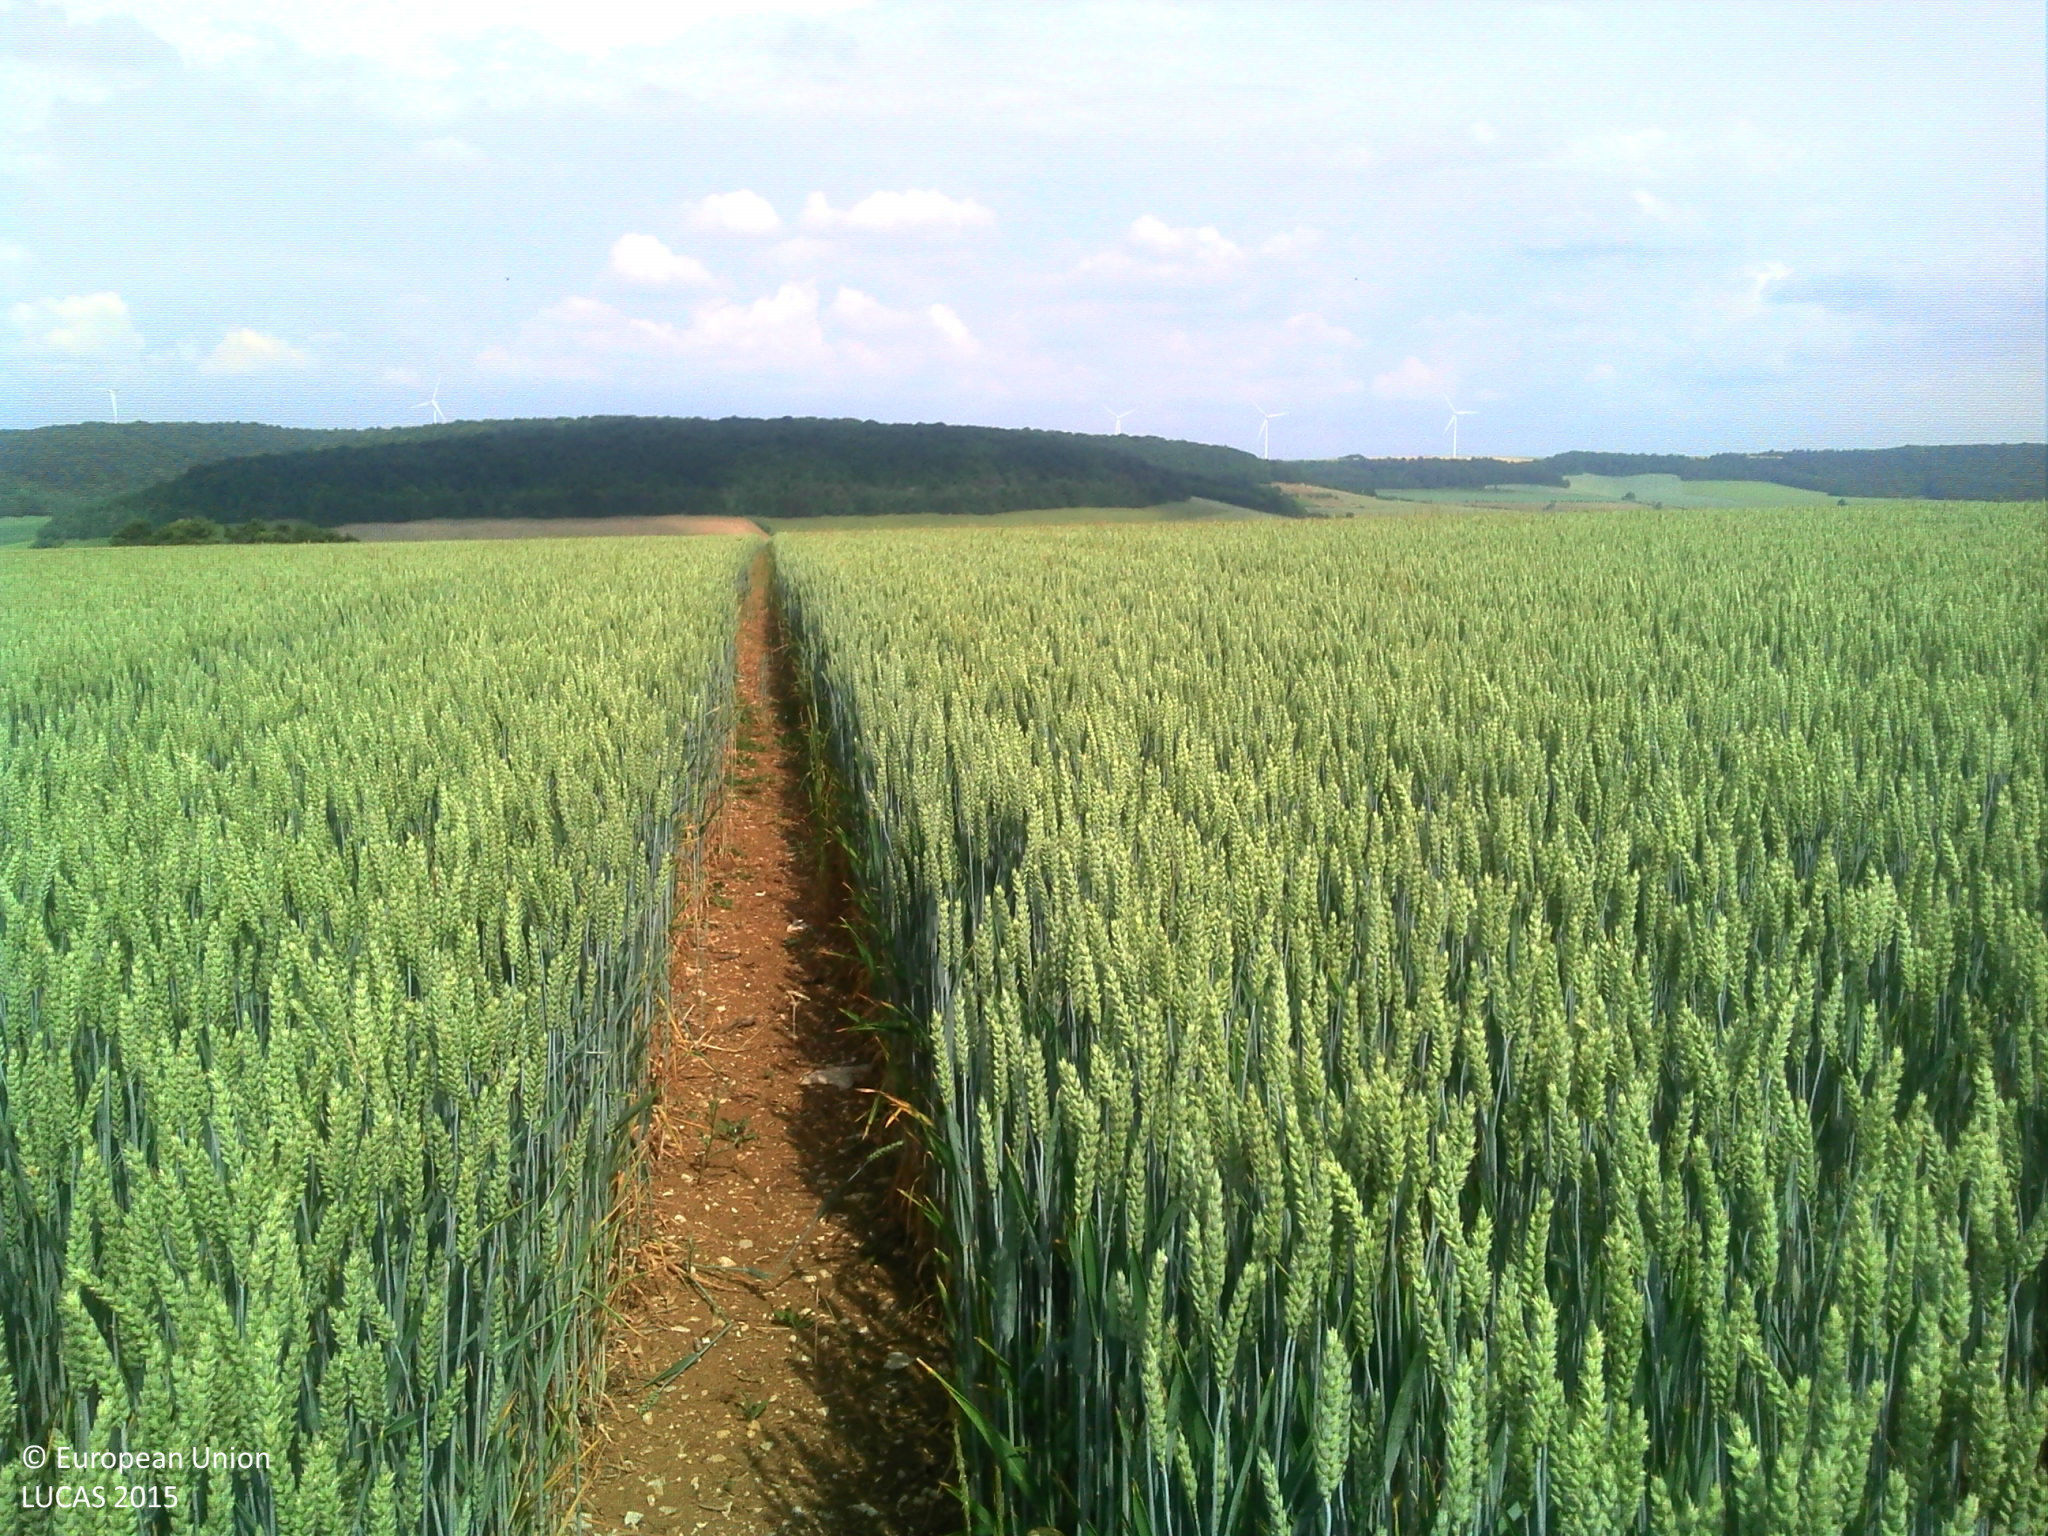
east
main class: Cropland
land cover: Common wheat
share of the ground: > 75 %
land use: Agriculture (excluding fallow land and kitchen gardens)
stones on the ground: 10 - 25 %
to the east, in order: Common wheat
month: June
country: FR
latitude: 48.3058
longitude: 4.9427
